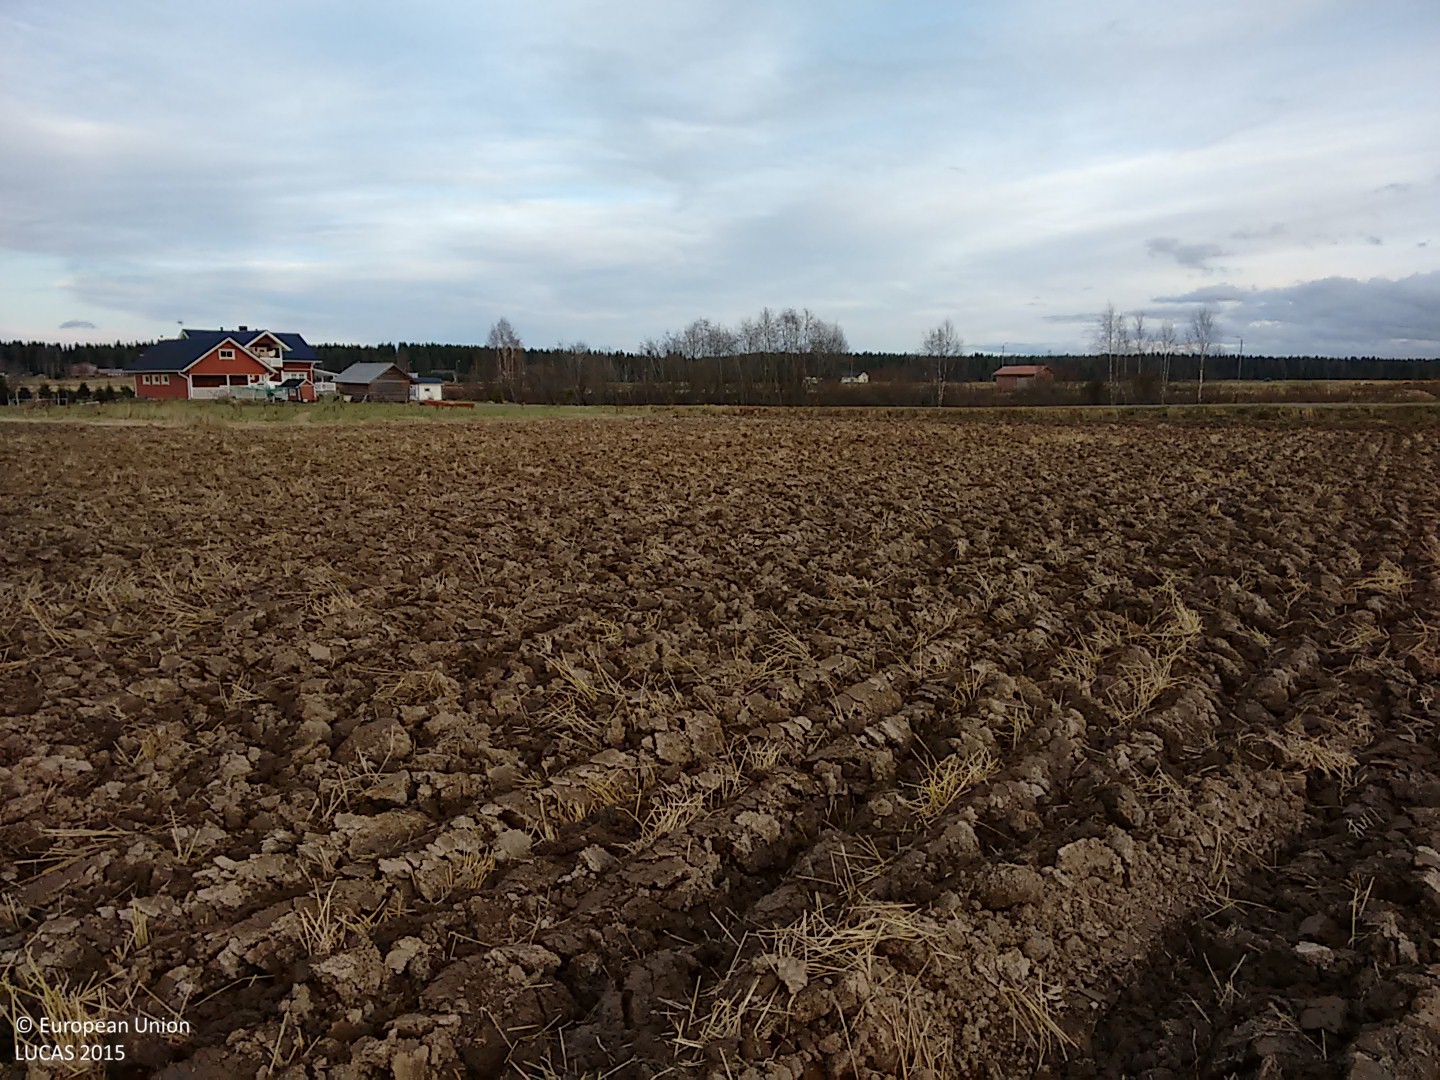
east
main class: Cropland
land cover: Barley
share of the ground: < 10 %
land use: Agriculture (excluding fallow land and kitchen gardens)
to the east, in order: Barley; Grass margins; Tracks; Grass margins; Spontaneously vegetated surfaces; Ponds and wetlands; Inland fresh running water; Broadleaved woodland; Spontaneously vegetated surfaces; Grass margins; Barley
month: October
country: FI
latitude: 63.9341
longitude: 25.0379
